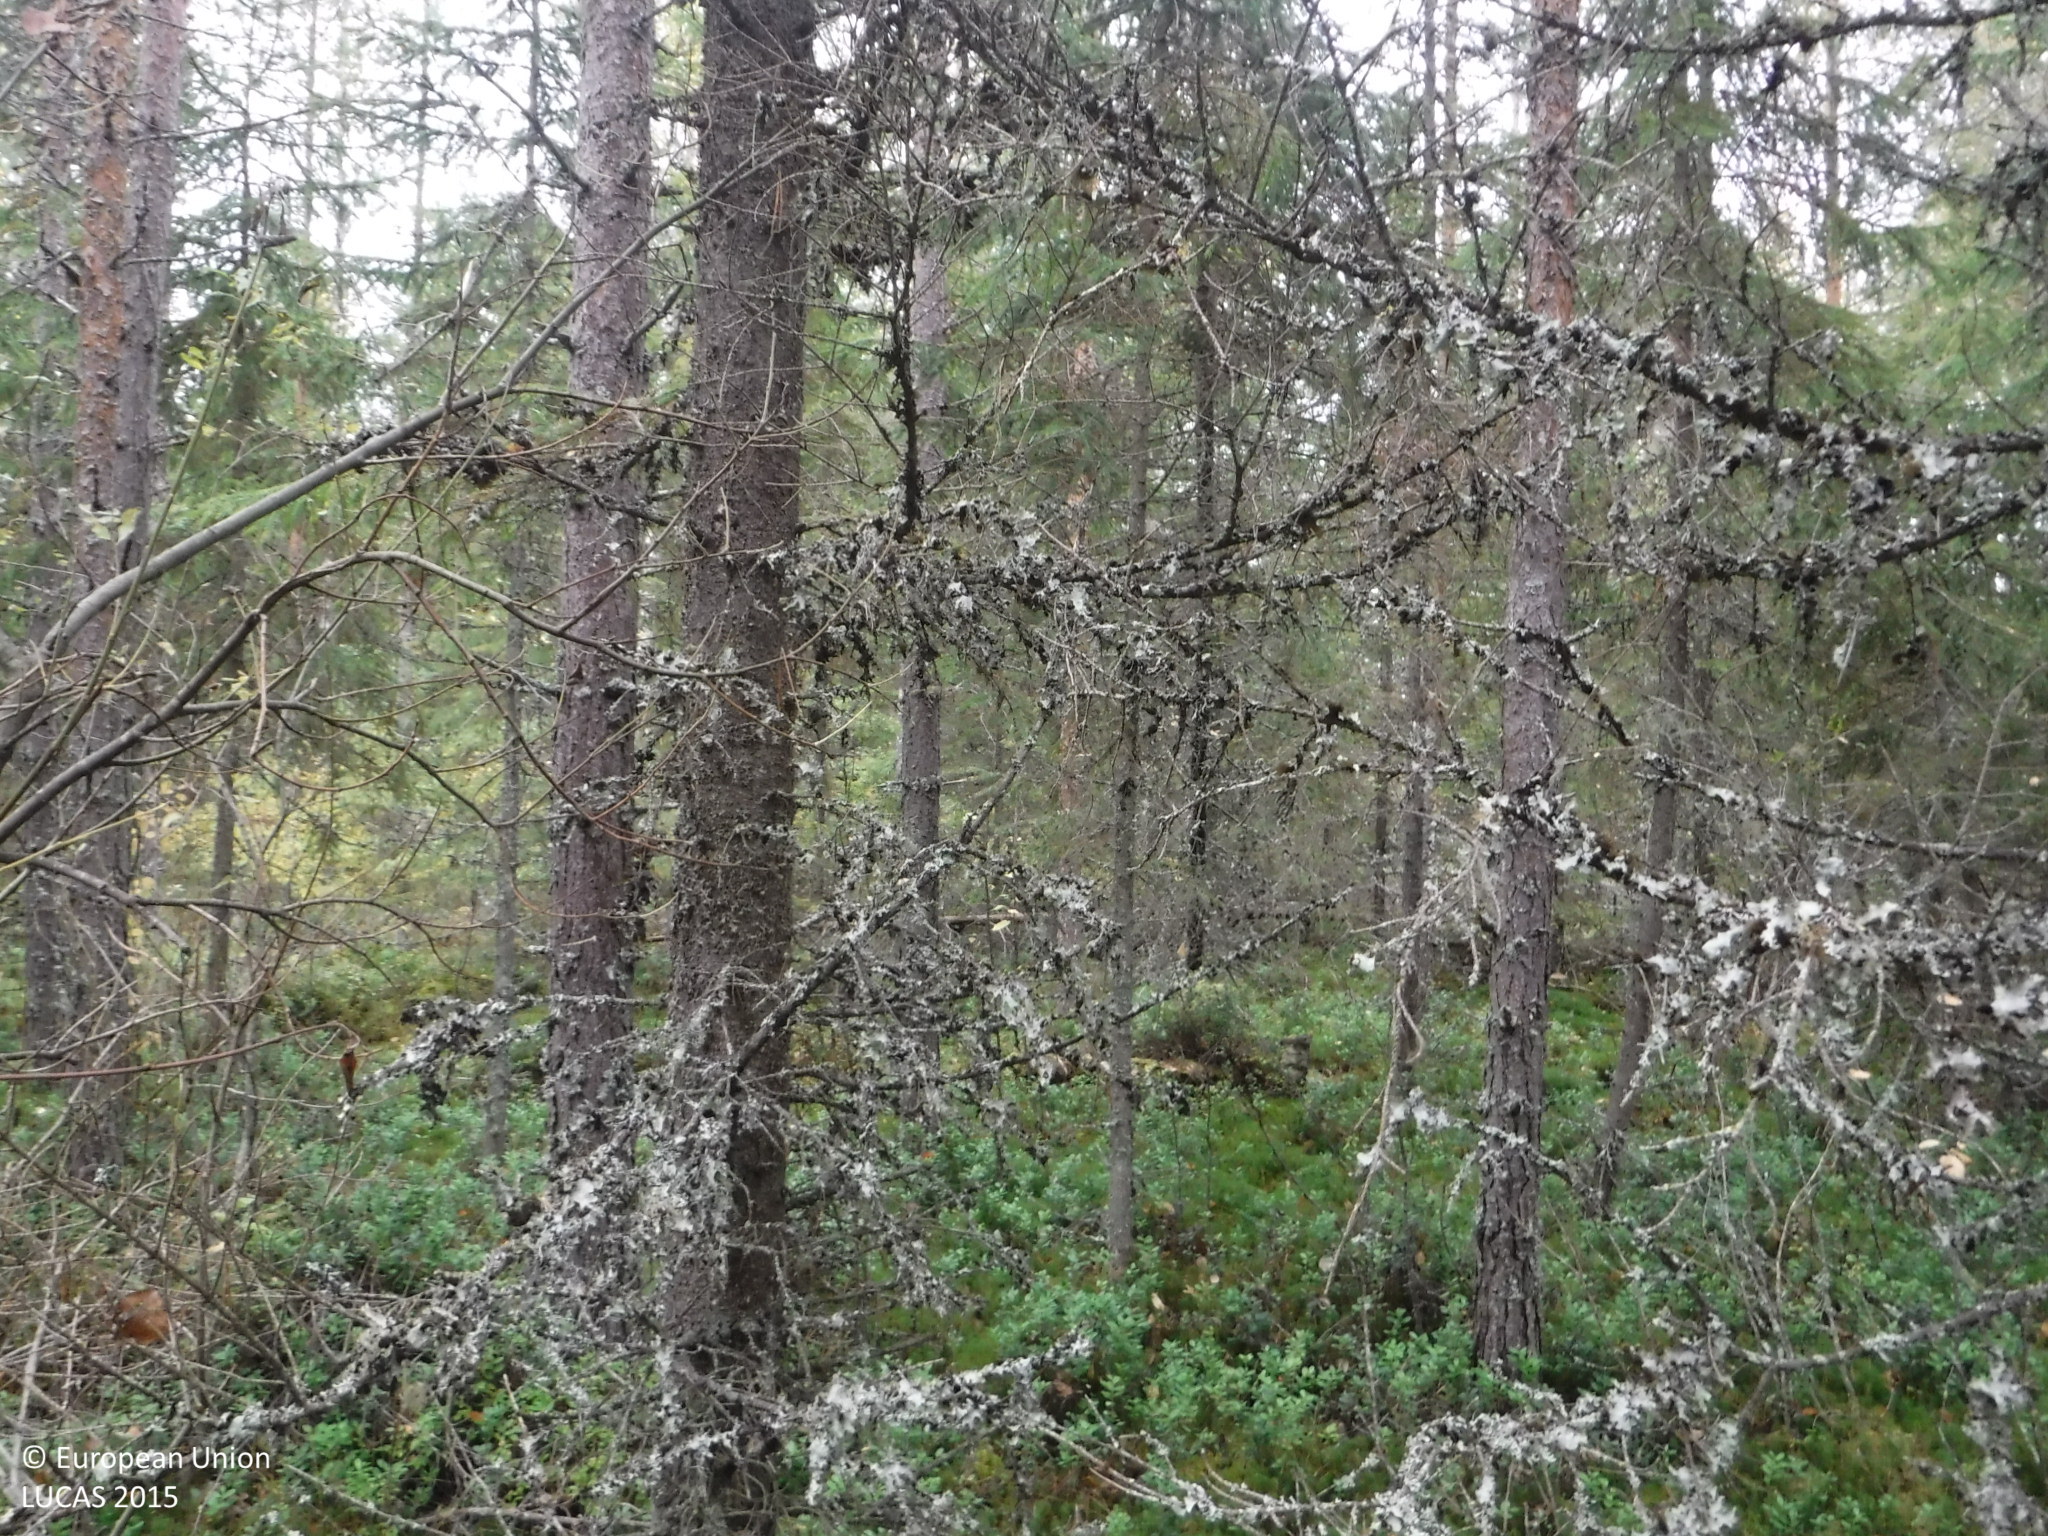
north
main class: Woodland
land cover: Other mixed woodland
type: boreal forest
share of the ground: 50 - 75 %
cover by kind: coniferous forest trees 30 %, shrubs 30 %, broadleaved forest trees 25 %, lichens and mosses 15 %
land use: Forestry
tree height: > 5 m
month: September
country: FI
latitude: 62.0708
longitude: 23.3347
